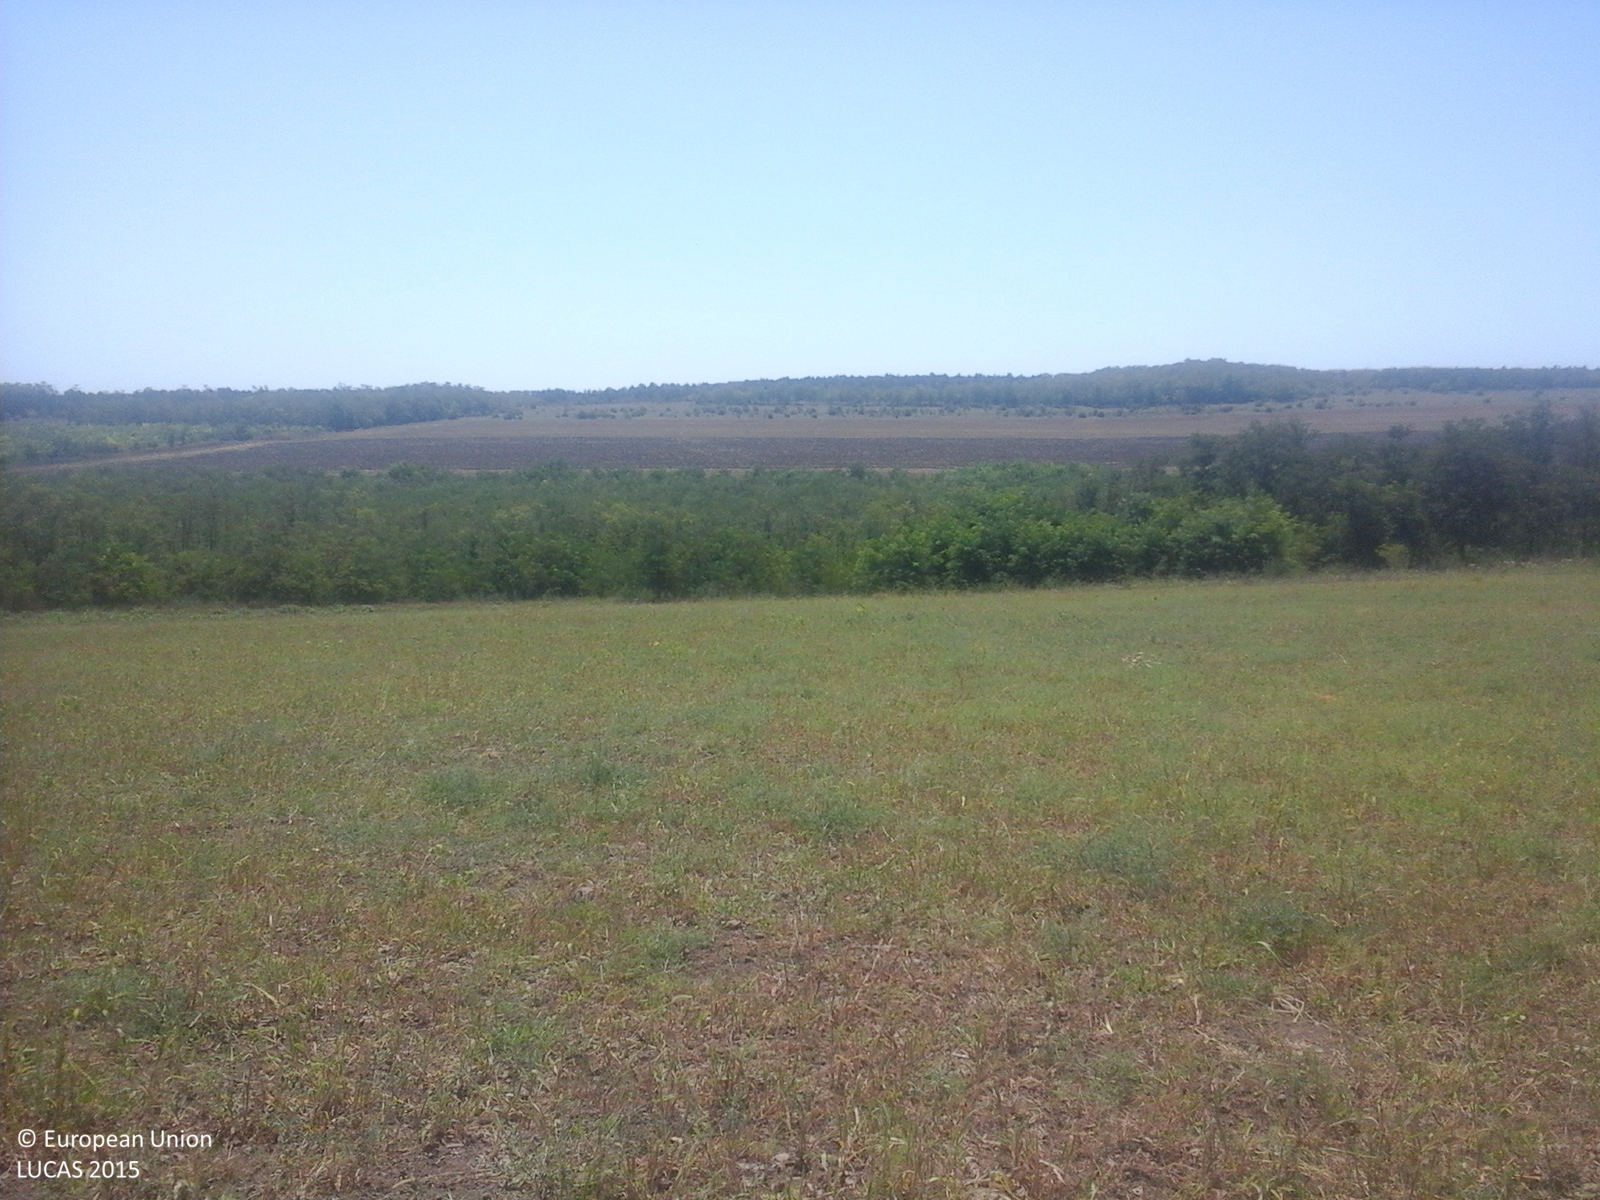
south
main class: Cropland
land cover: Other cereals
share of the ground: 50 - 75 %
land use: Agriculture (excluding fallow land and kitchen gardens)
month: August
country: RO
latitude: 44.5853
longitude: 28.3188
